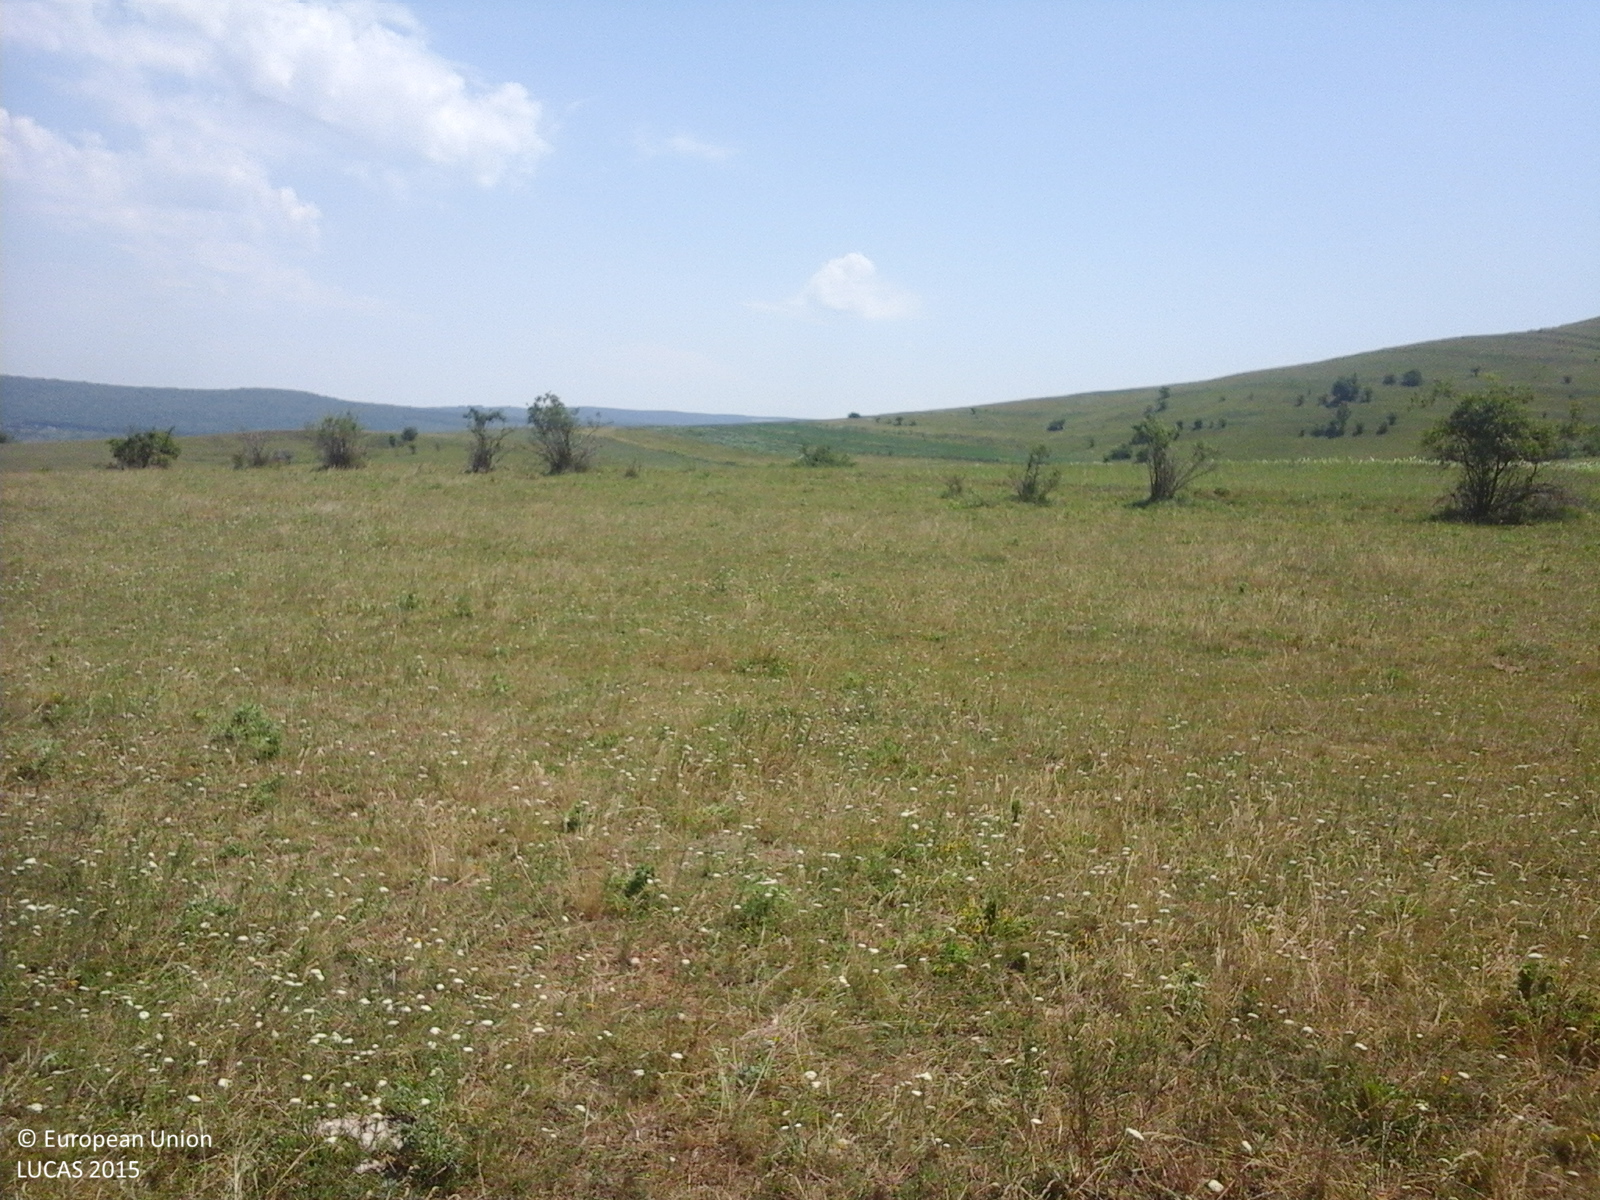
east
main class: Grassland
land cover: Grassland without tree/shrub cover
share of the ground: > 75 %
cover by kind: herbaceous plants 100 %
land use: Agriculture (excluding fallow land and kitchen gardens)
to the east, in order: Grassland without tree/shrub cover; Ditches and canals; Abandoned hedges; Grassland without tree/shrub cover
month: June
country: RO
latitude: 46.8749
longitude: 27.8777
